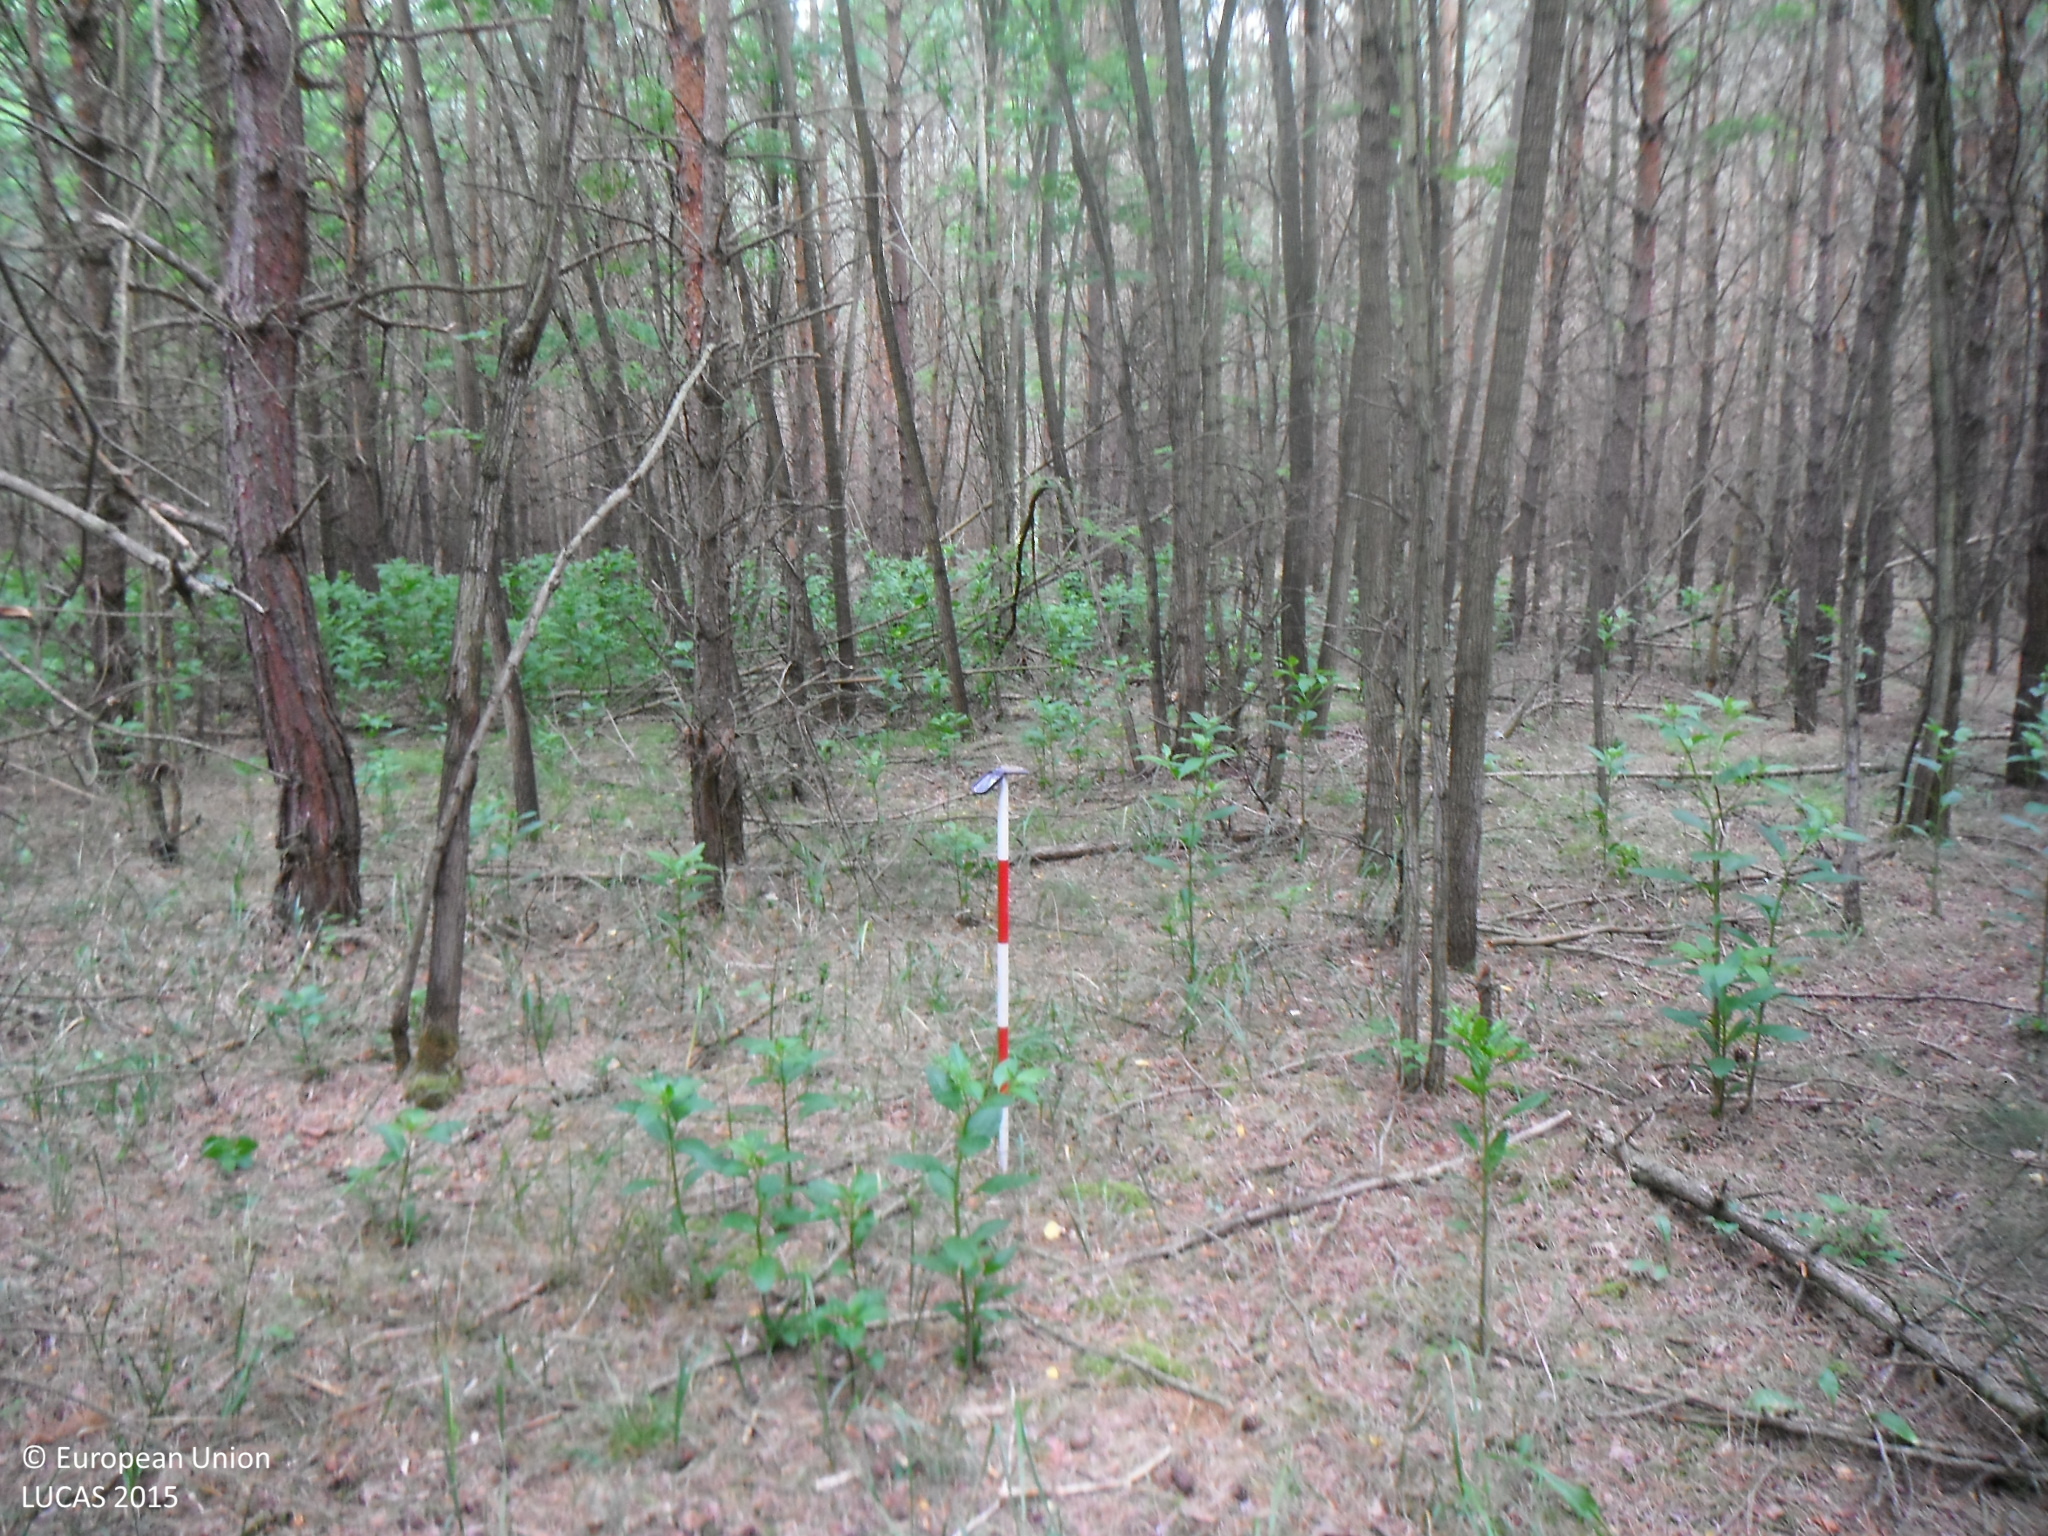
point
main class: Woodland
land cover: Pine dominated mixed woodland
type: hemiboreal forest and nemoral coniferous forest and mixed broadleaved-coniferous forest
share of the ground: > 75 %
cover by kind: coniferous forest trees 50 %, broadleaved forest trees 45 %, herbaceous plants 5 %
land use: Forestry
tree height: > 5 m
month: June
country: SK
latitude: 48.6229
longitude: 17.1587
